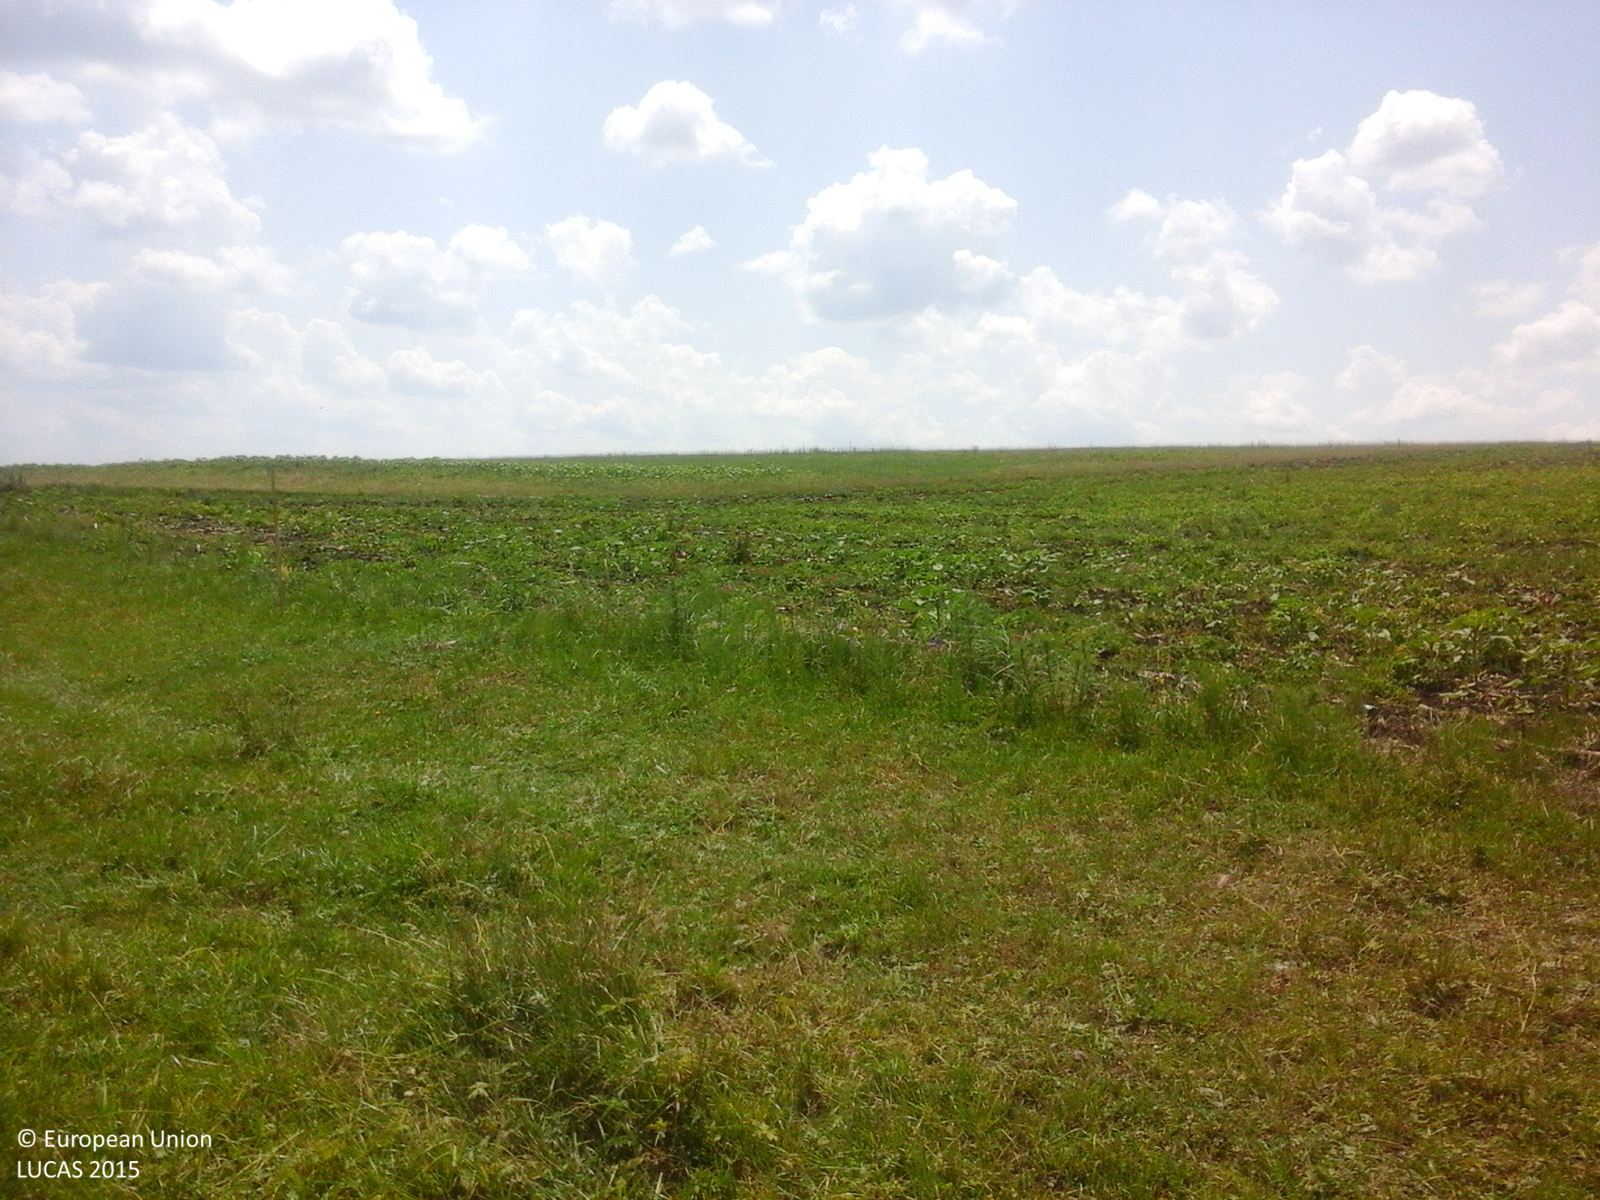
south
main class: Grassland
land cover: Grassland without tree/shrub cover
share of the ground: > 75 %
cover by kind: herbaceous plants 100 %
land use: Agriculture (excluding fallow land and kitchen gardens)
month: June
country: RO
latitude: 48.0281
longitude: 26.6578
